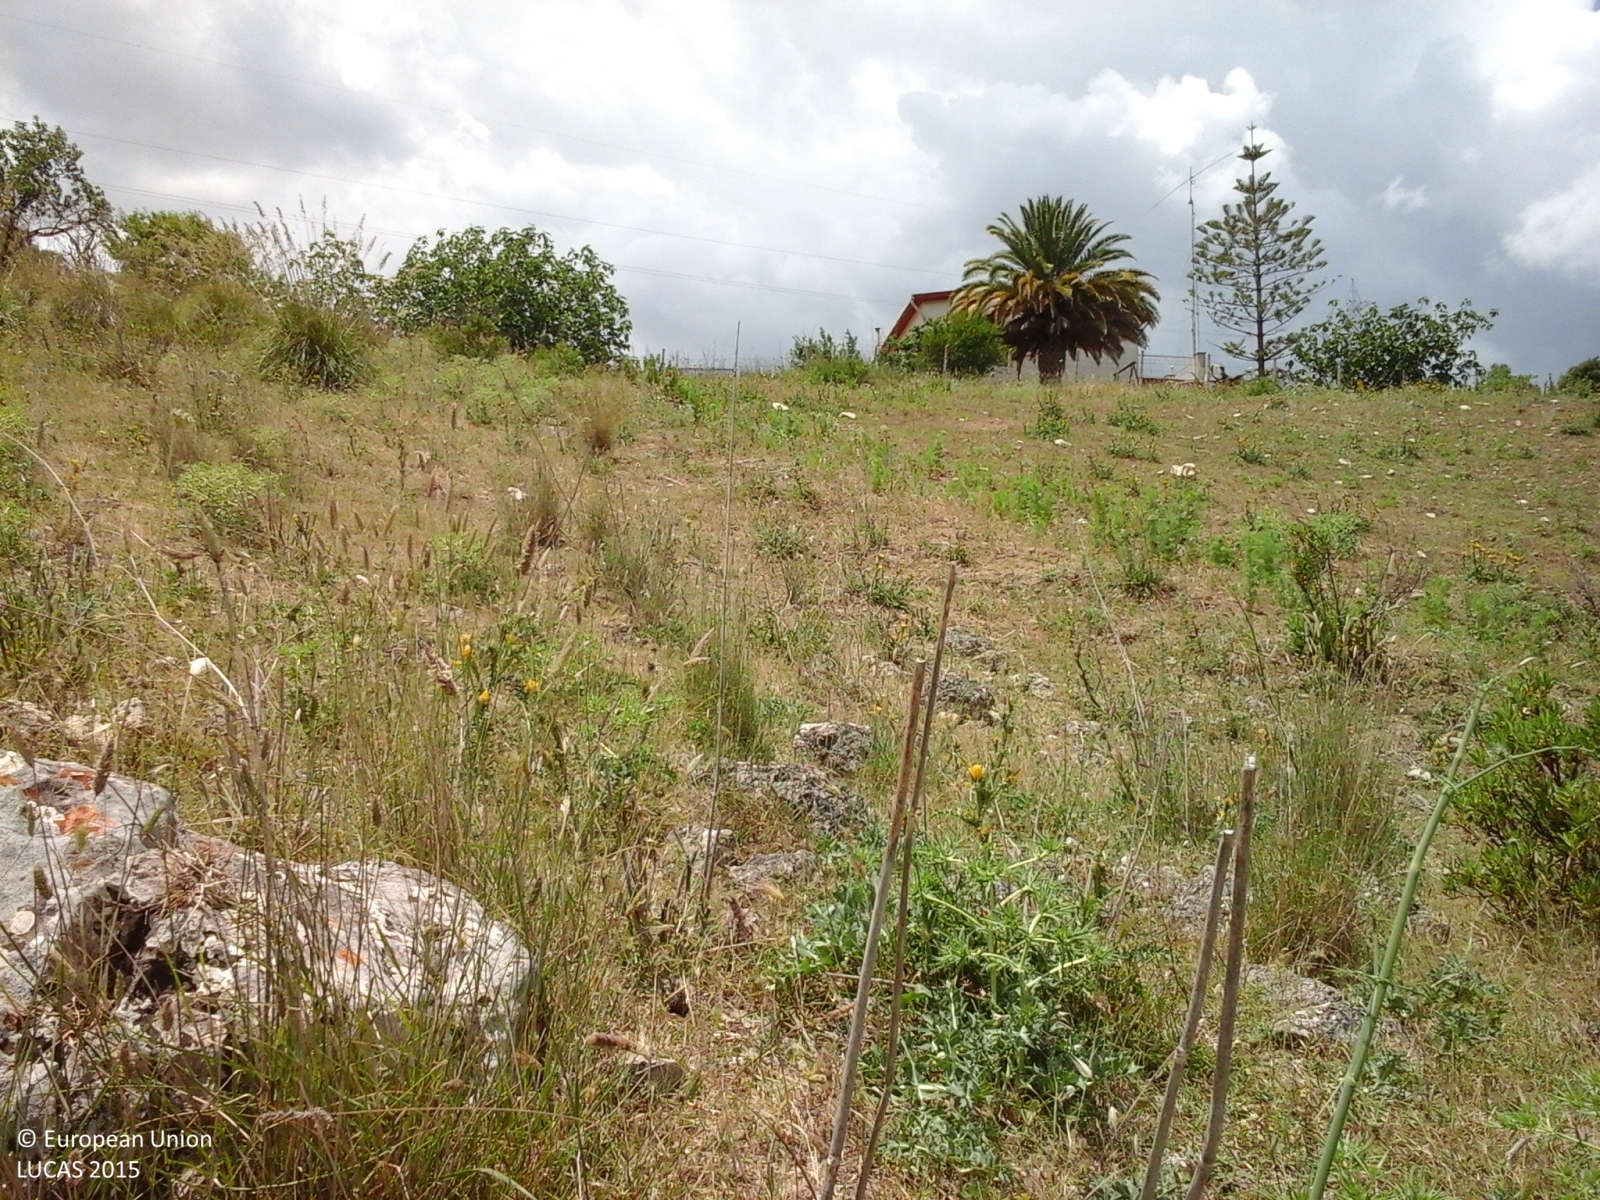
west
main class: Grassland
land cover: Grassland with sparse tree/shrub cover
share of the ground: > 75 %
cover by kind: herbaceous plants 90 %, broadleaved forest trees 5 %, shrubs 5 %
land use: Semi-natural and natural areas not in use
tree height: < 5 m
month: June
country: IT
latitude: 37.5494
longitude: 13.6737
